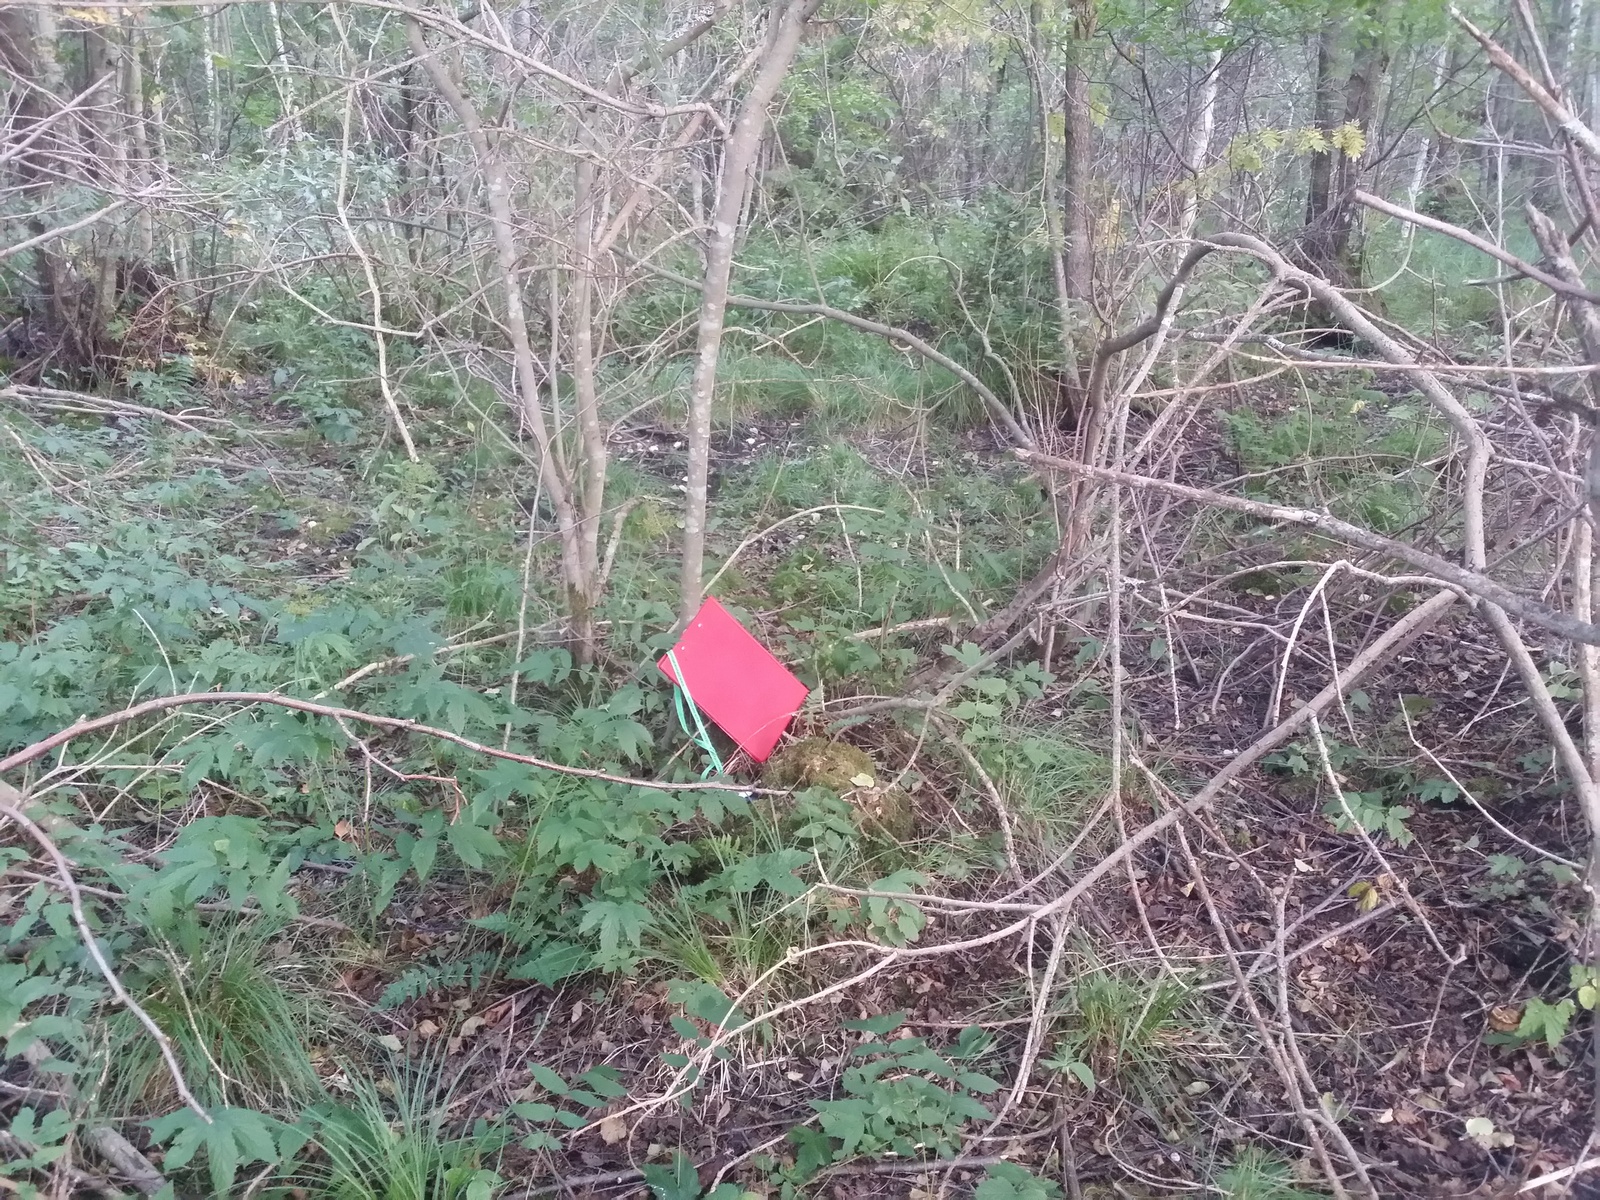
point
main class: Woodland
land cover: Broadleaved woodland
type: non-riverine alder, birch or aspen forest
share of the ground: > 75 %
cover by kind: broadleaved forest trees 85 %, herbaceous plants 10 %, unconsolidated bare surface 5 %
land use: Forestry
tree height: > 5 m
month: August
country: LV
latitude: 57.2337
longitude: 27.6930
